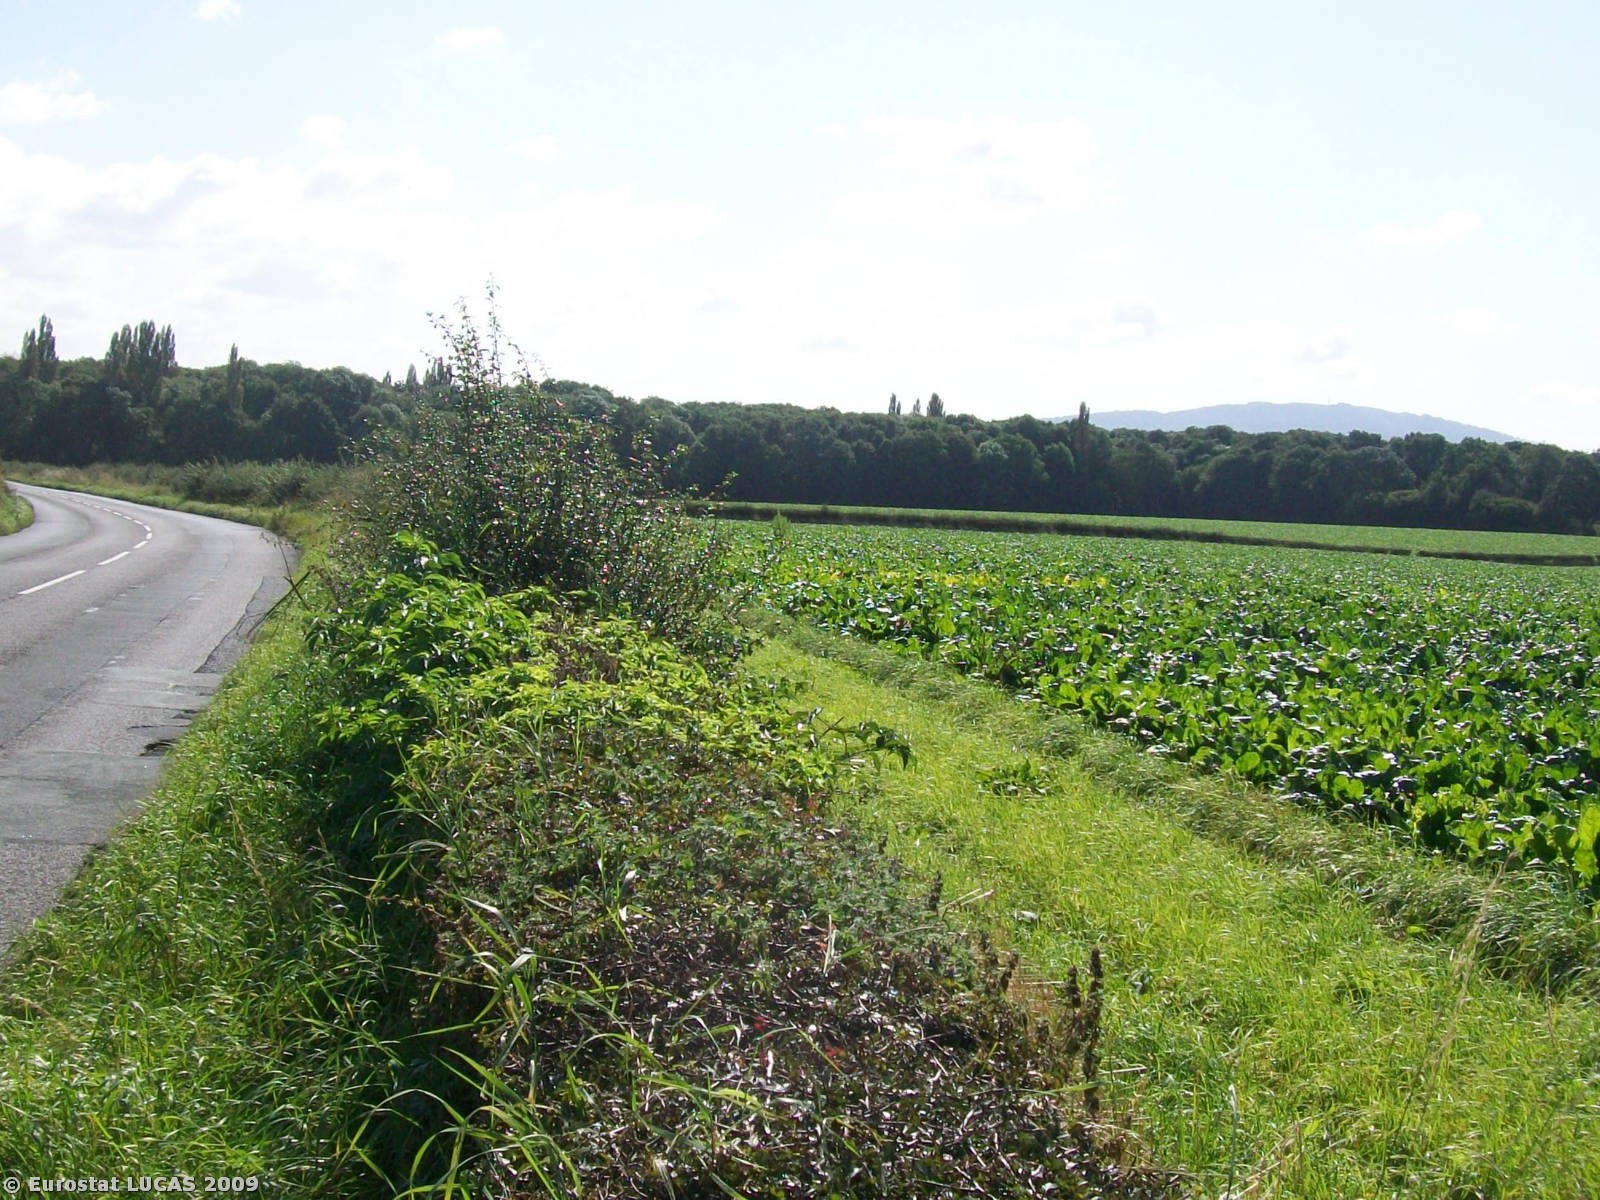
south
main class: Cropland
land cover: Sugar beet
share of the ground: > 75 %
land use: Agriculture (excluding fallow land and kitchen gardens)
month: September
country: GB
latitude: 52.7422
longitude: -2.5840
